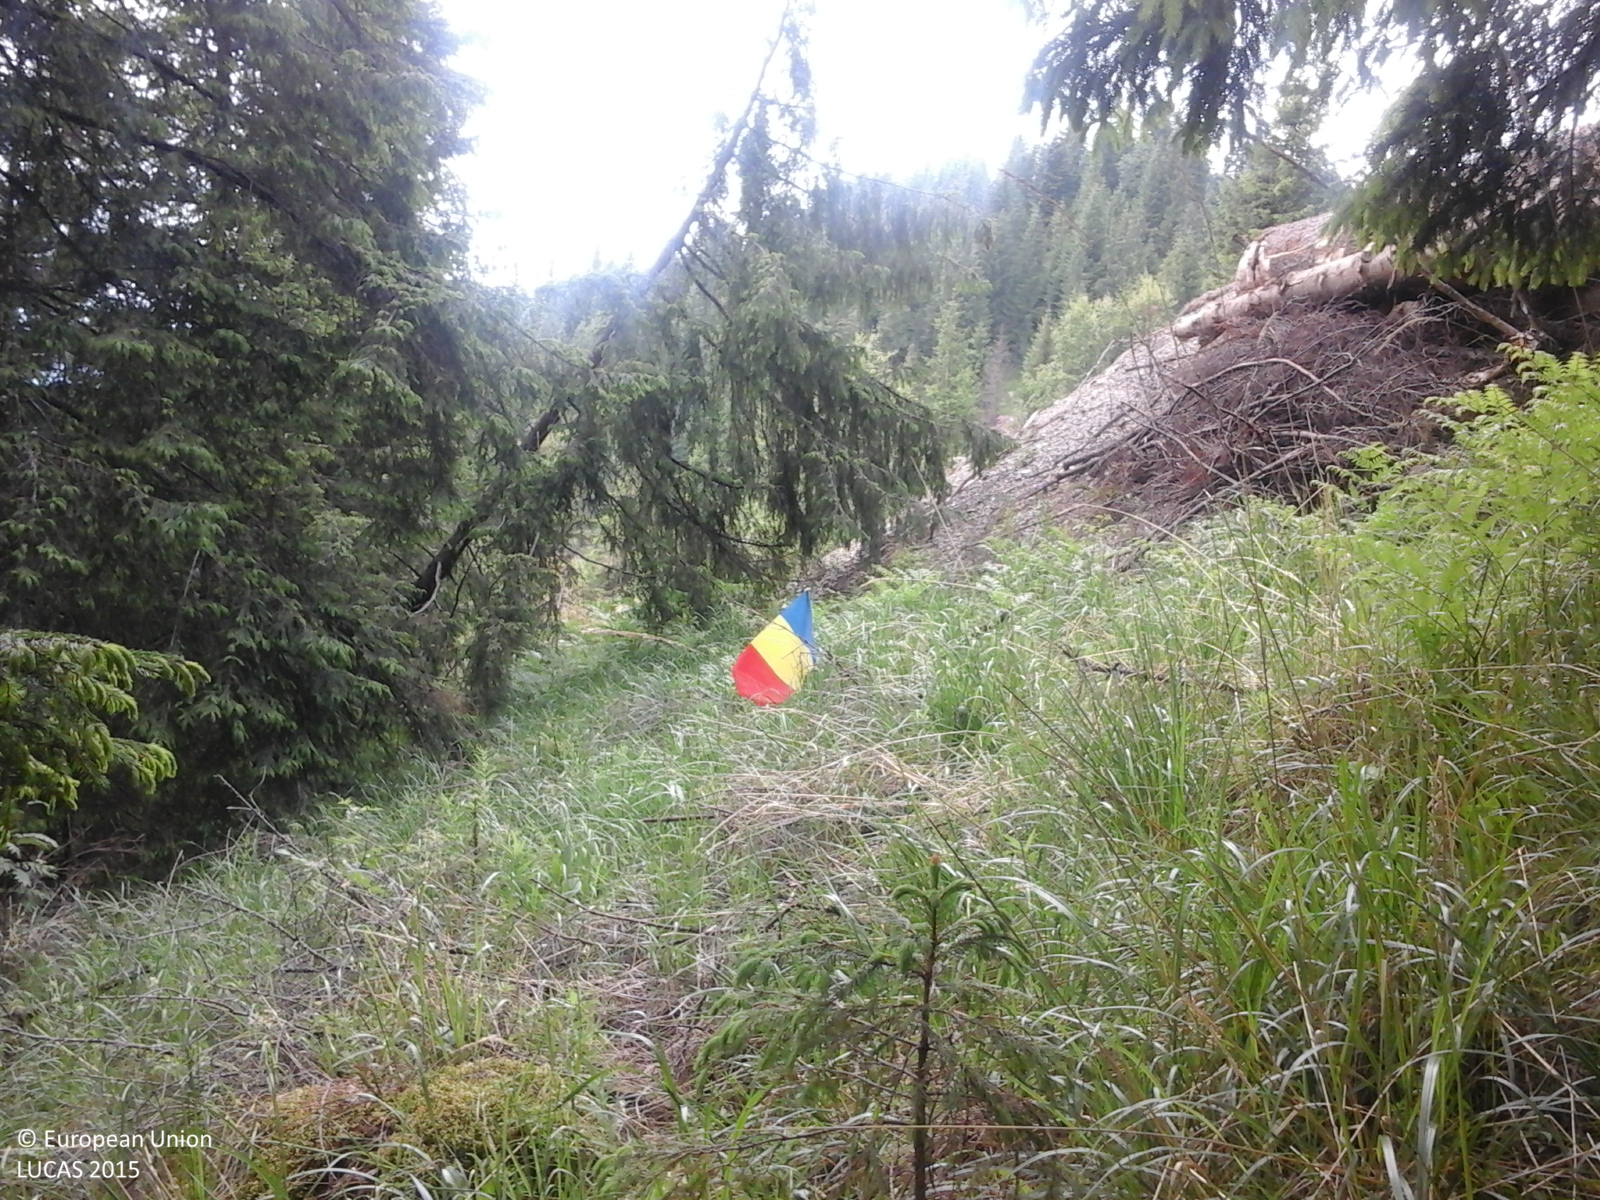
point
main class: Woodland
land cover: Spruce dominated coniferous woodland
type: alpine coniferous forest
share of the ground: > 75 %
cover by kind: coniferous forest trees 90 %, herbaceous plants 10 %
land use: Forestry
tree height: > 5 m
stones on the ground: 10 - 25 %
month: June
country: RO
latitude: 47.3072
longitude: 25.7146
